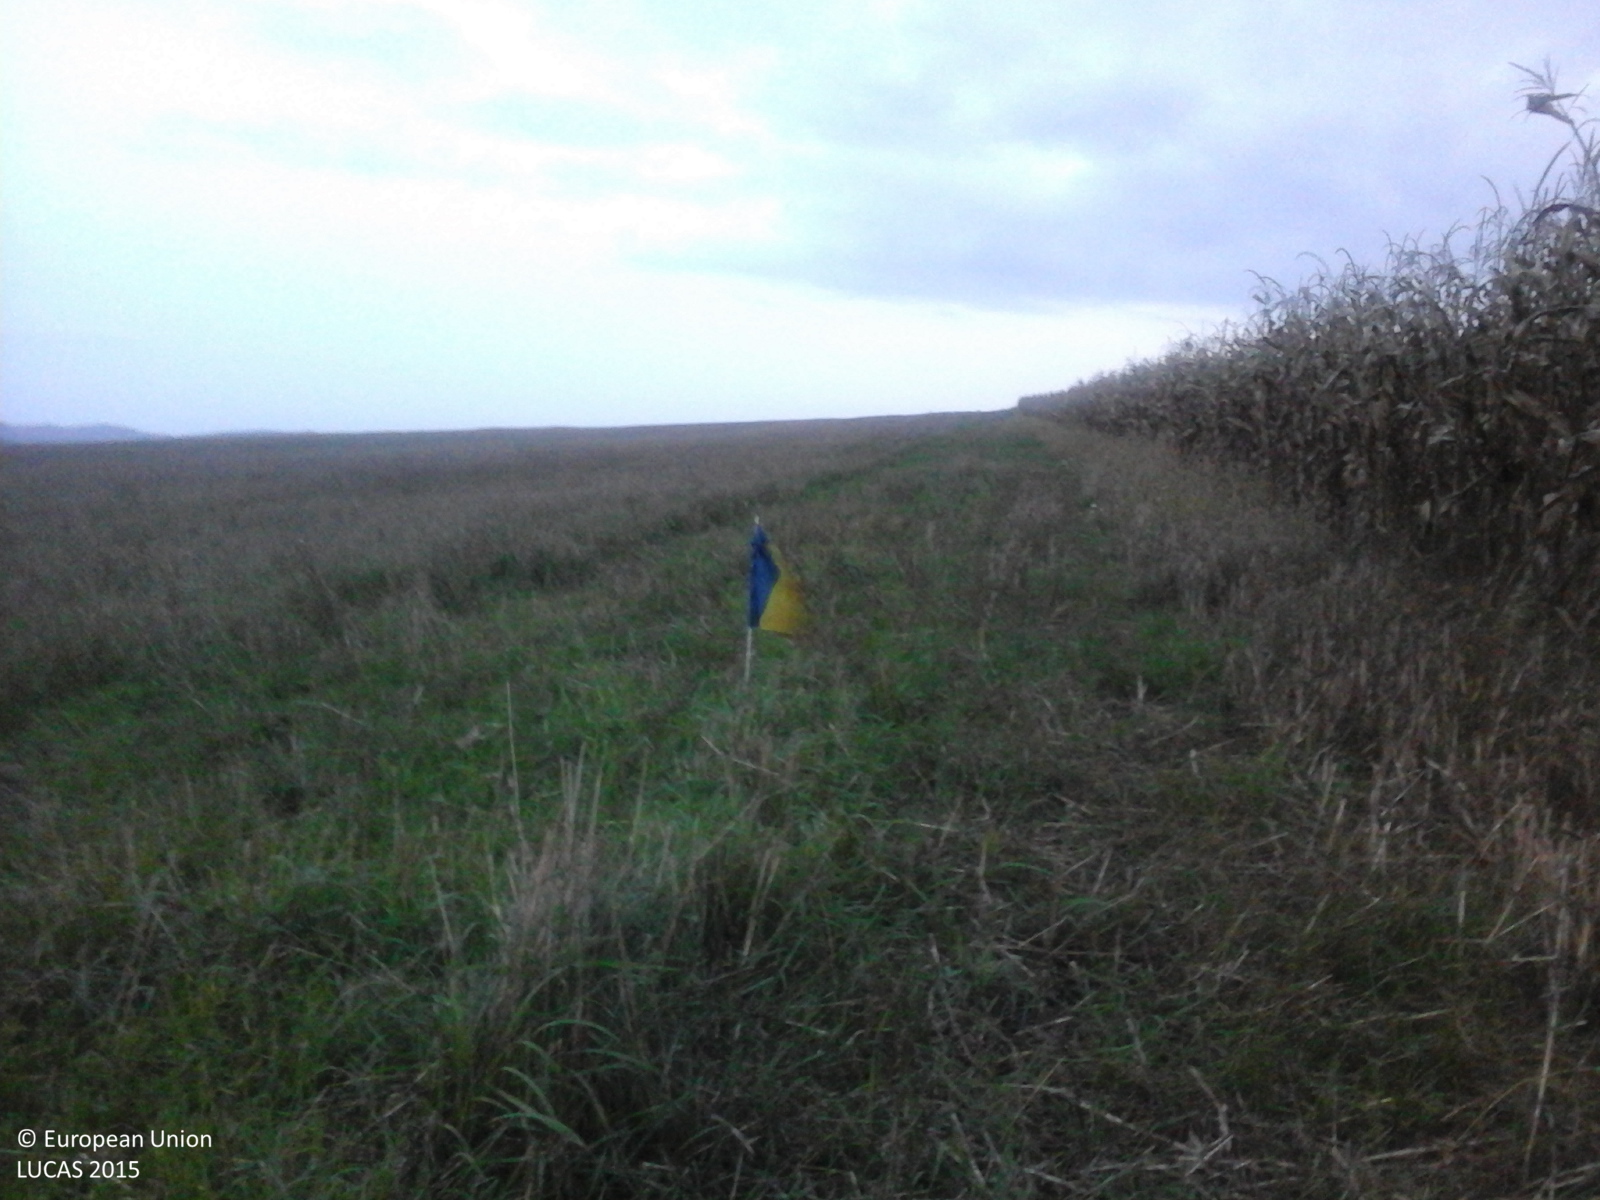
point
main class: Grassland
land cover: Grassland without tree/shrub cover
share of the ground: > 75 %
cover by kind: herbaceous plants 100 %
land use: Agriculture (excluding fallow land and kitchen gardens)
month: October
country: RO
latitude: 46.3212
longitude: 23.8529
